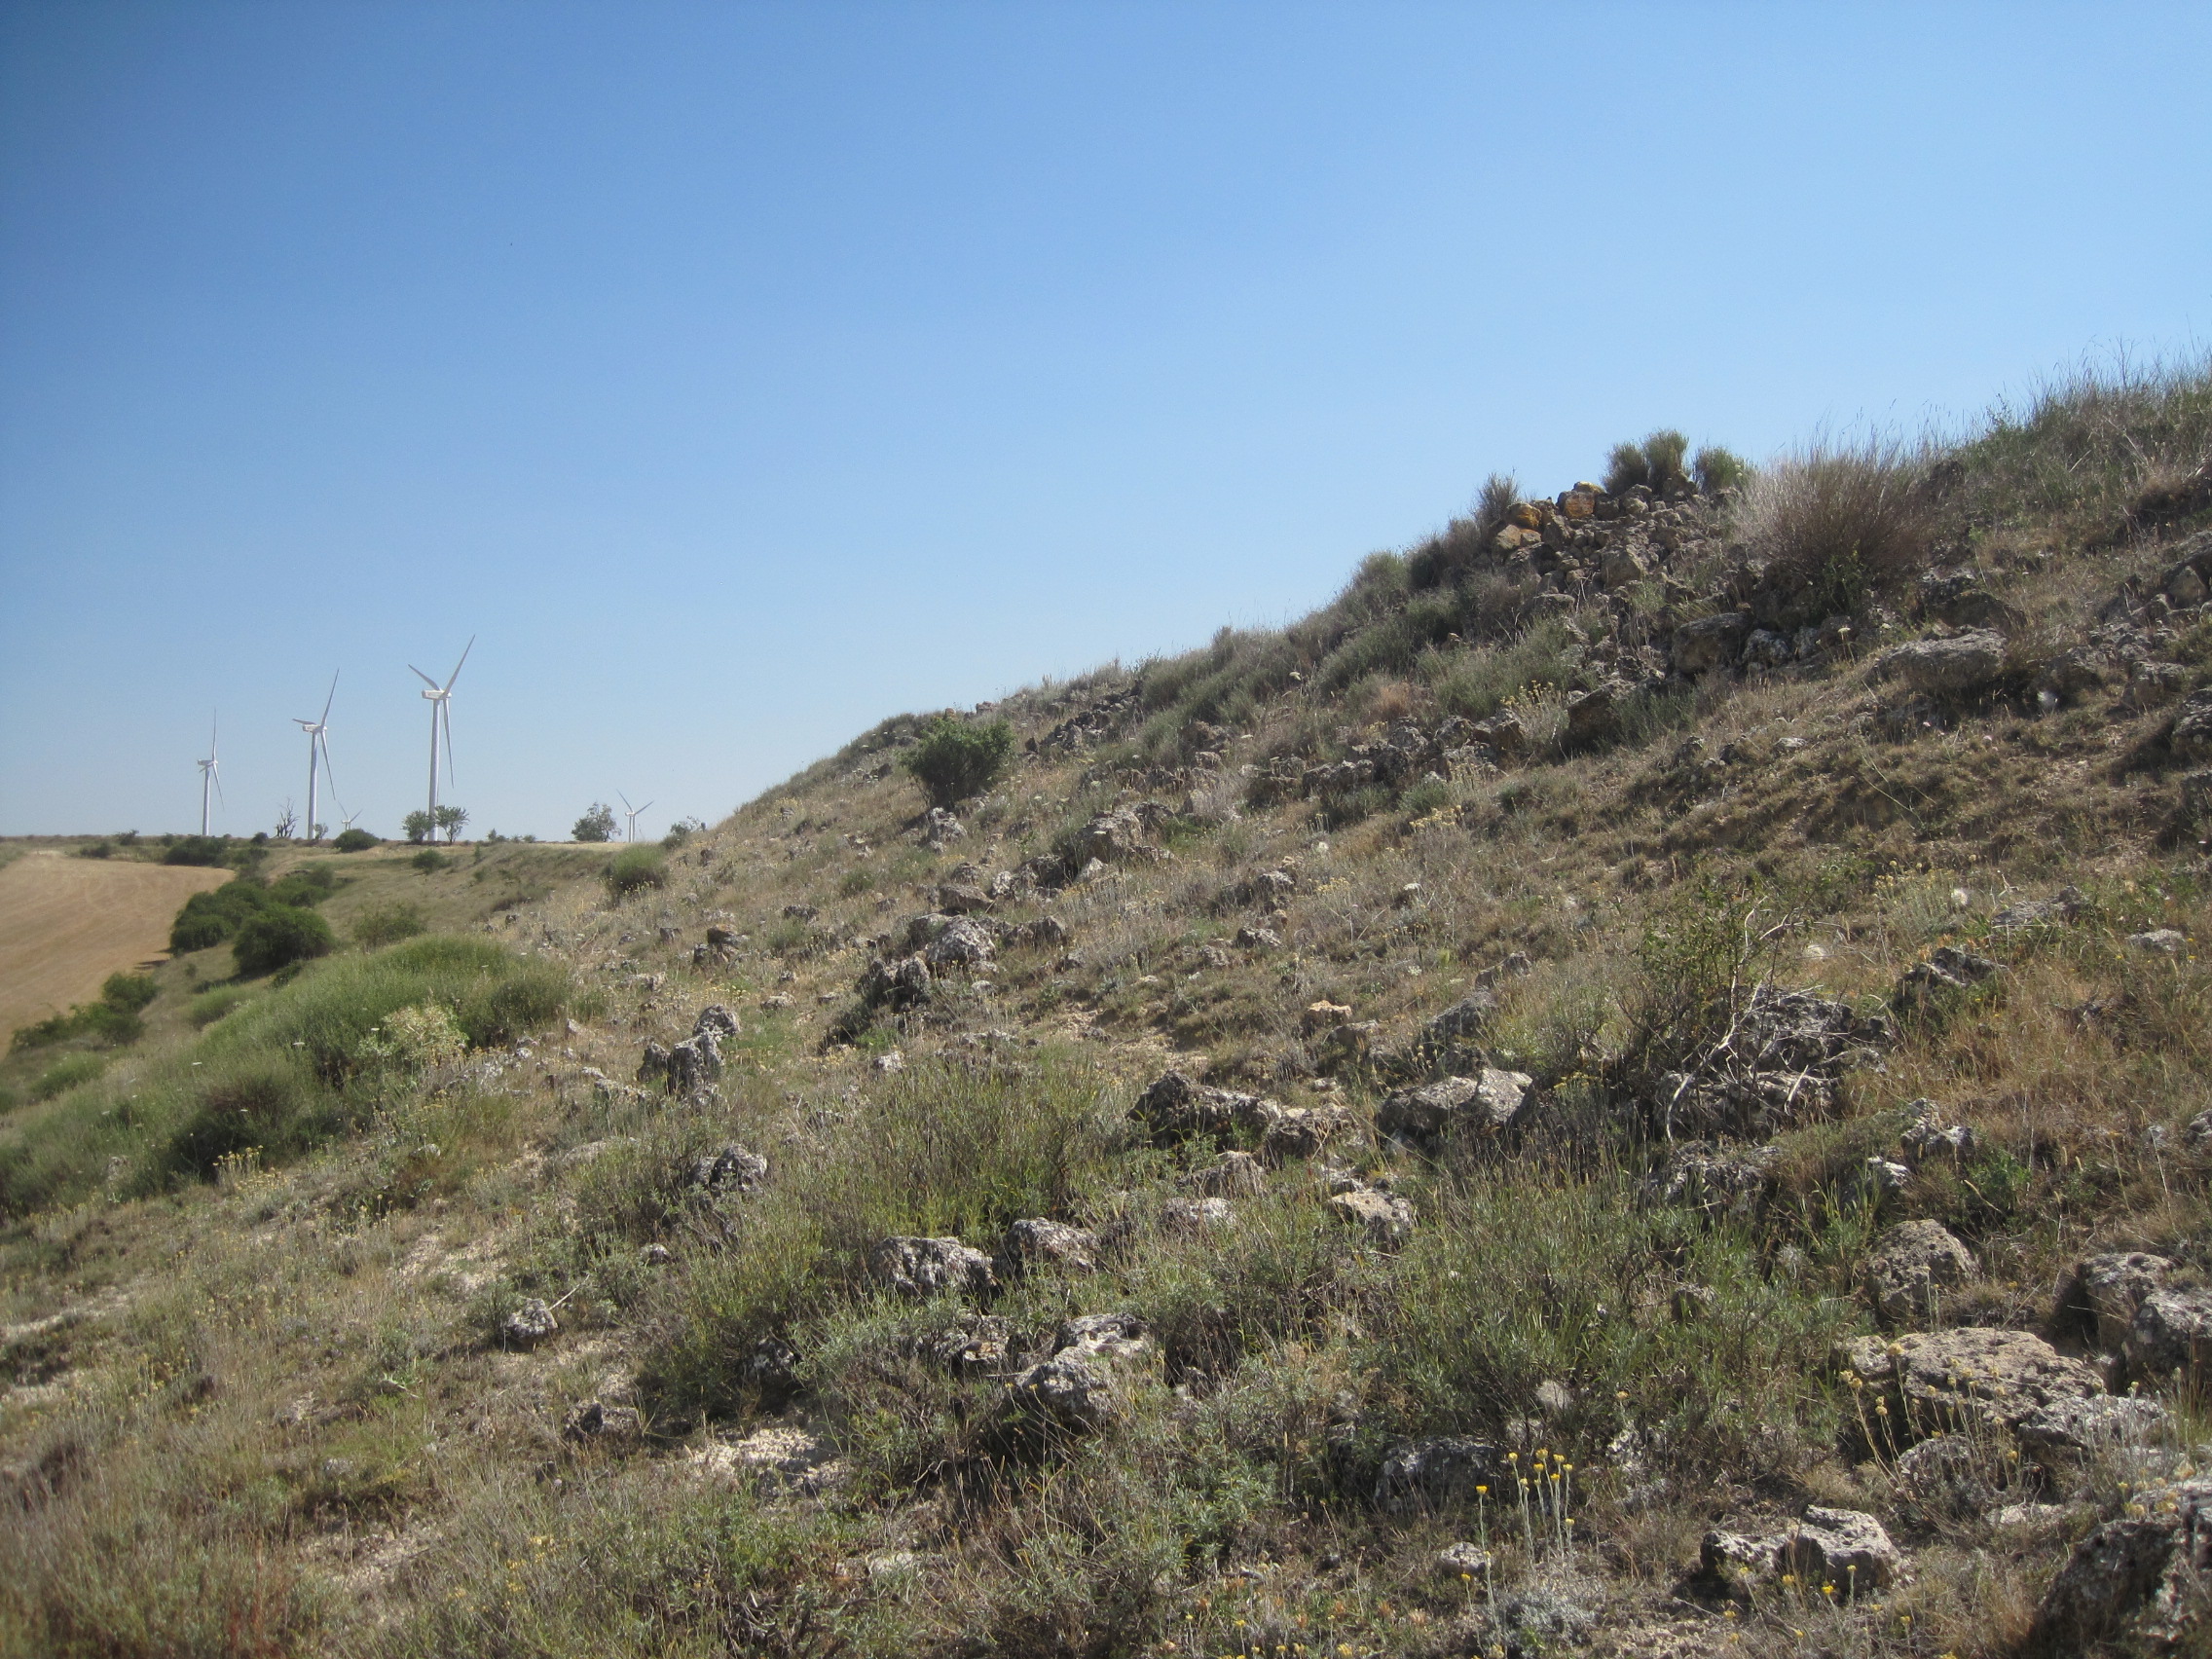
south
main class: Grassland
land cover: Grassland without tree/shrub cover
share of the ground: > 75 %
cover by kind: herbaceous plants 95 %, shrubs 5 %
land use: Semi-natural and natural areas not in use
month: July
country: ES
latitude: 41.9126
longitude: -4.7698
